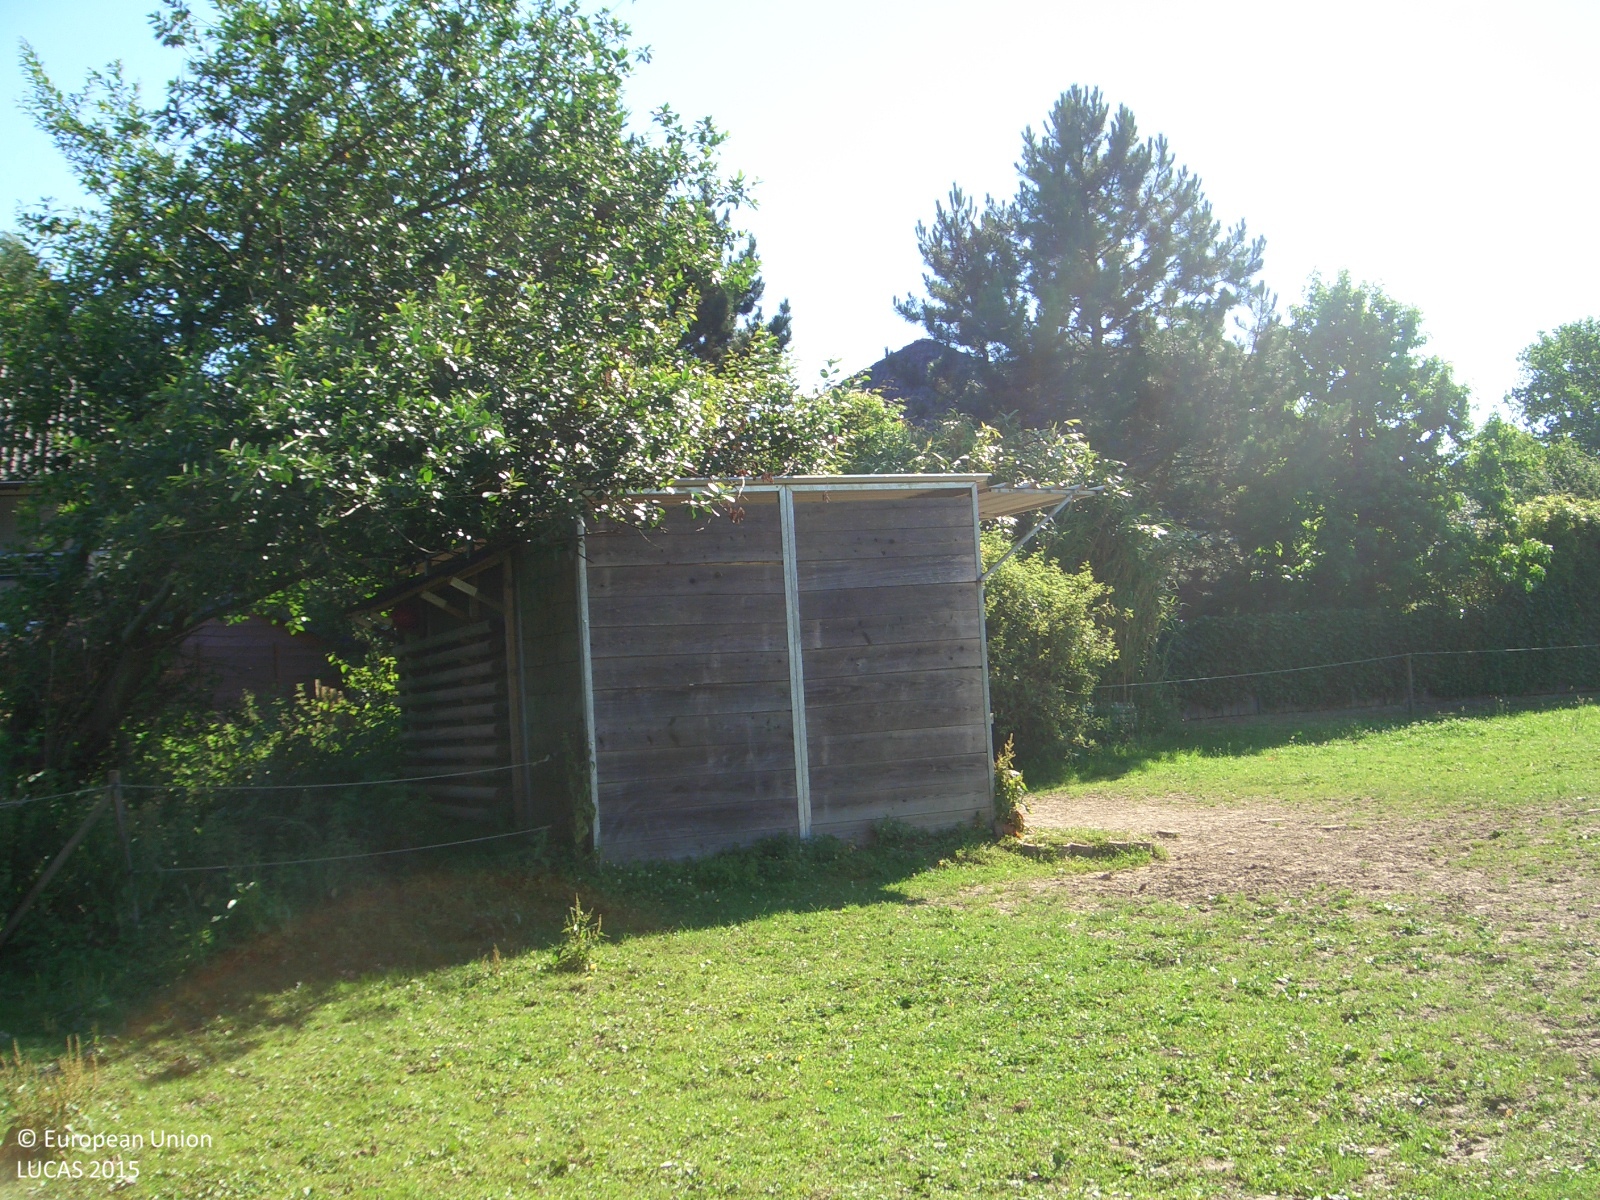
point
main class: Woodland
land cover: Pine dominated coniferous woodland
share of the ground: > 75 %
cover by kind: coniferous forest trees 100 %
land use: Residential
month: July
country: DE
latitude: 51.1534
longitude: 7.0405
